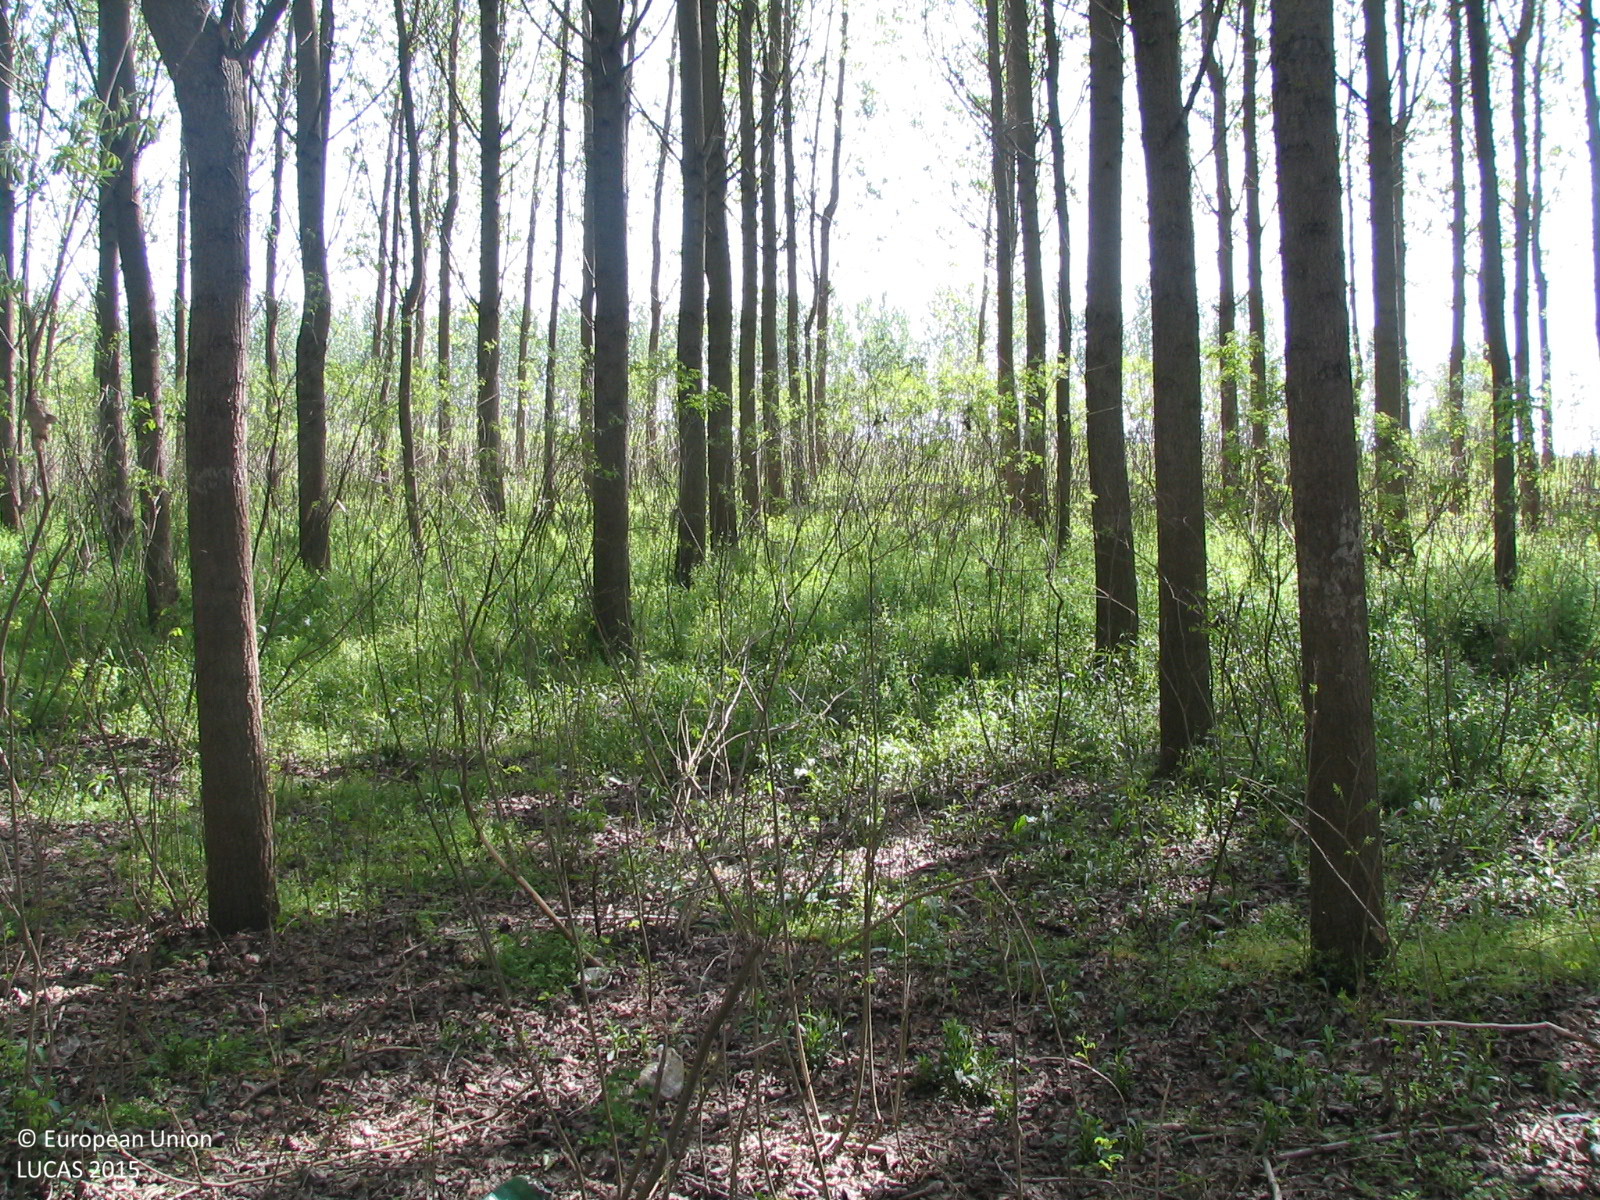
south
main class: Woodland
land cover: Broadleaved woodland
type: floodplain forest
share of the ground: > 75 %
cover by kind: broadleaved forest trees 90 %, shrubs 5 %, herbaceous plants 5 %
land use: Forestry
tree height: > 5 m
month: May
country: BG
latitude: 43.6879
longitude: 24.1378
